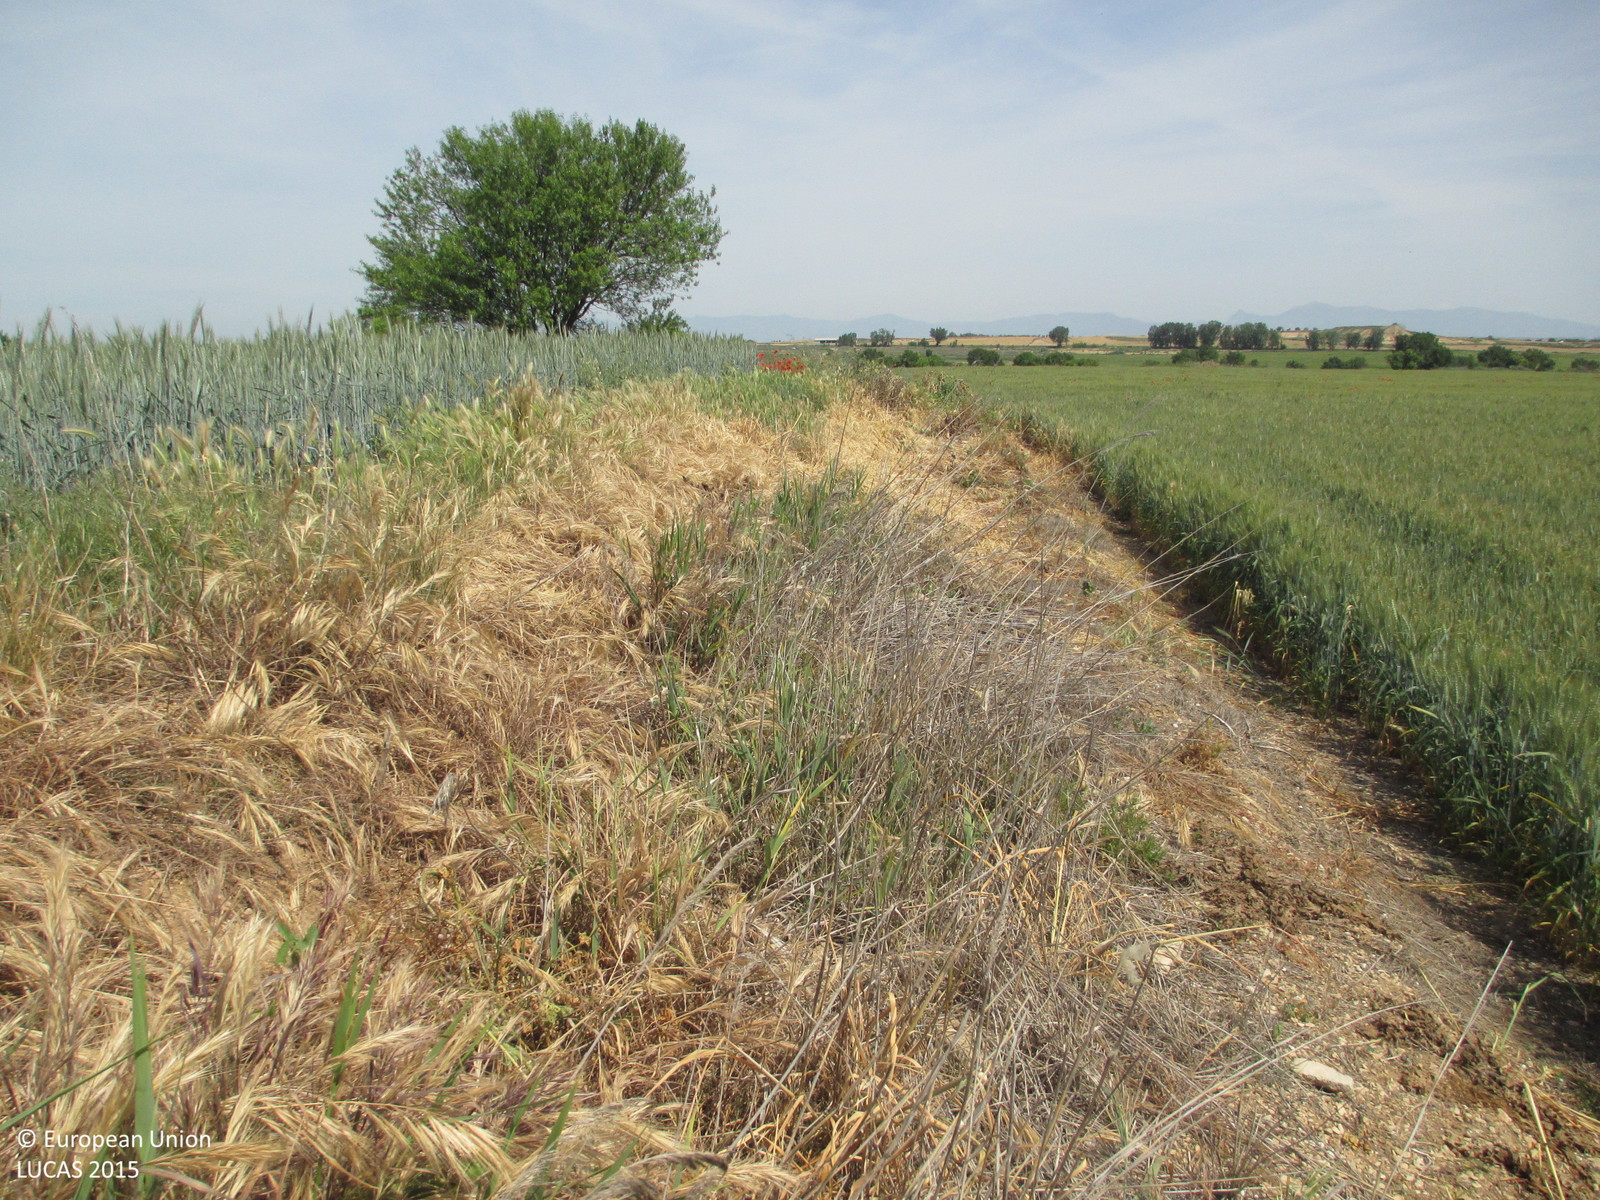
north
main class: Grassland
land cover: Spontaneously vegetated surfaces
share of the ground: > 75 %
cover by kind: herbaceous plants 100 %
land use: Agriculture (excluding fallow land and kitchen gardens)
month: May
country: ES
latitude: 41.8786
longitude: -0.4195
